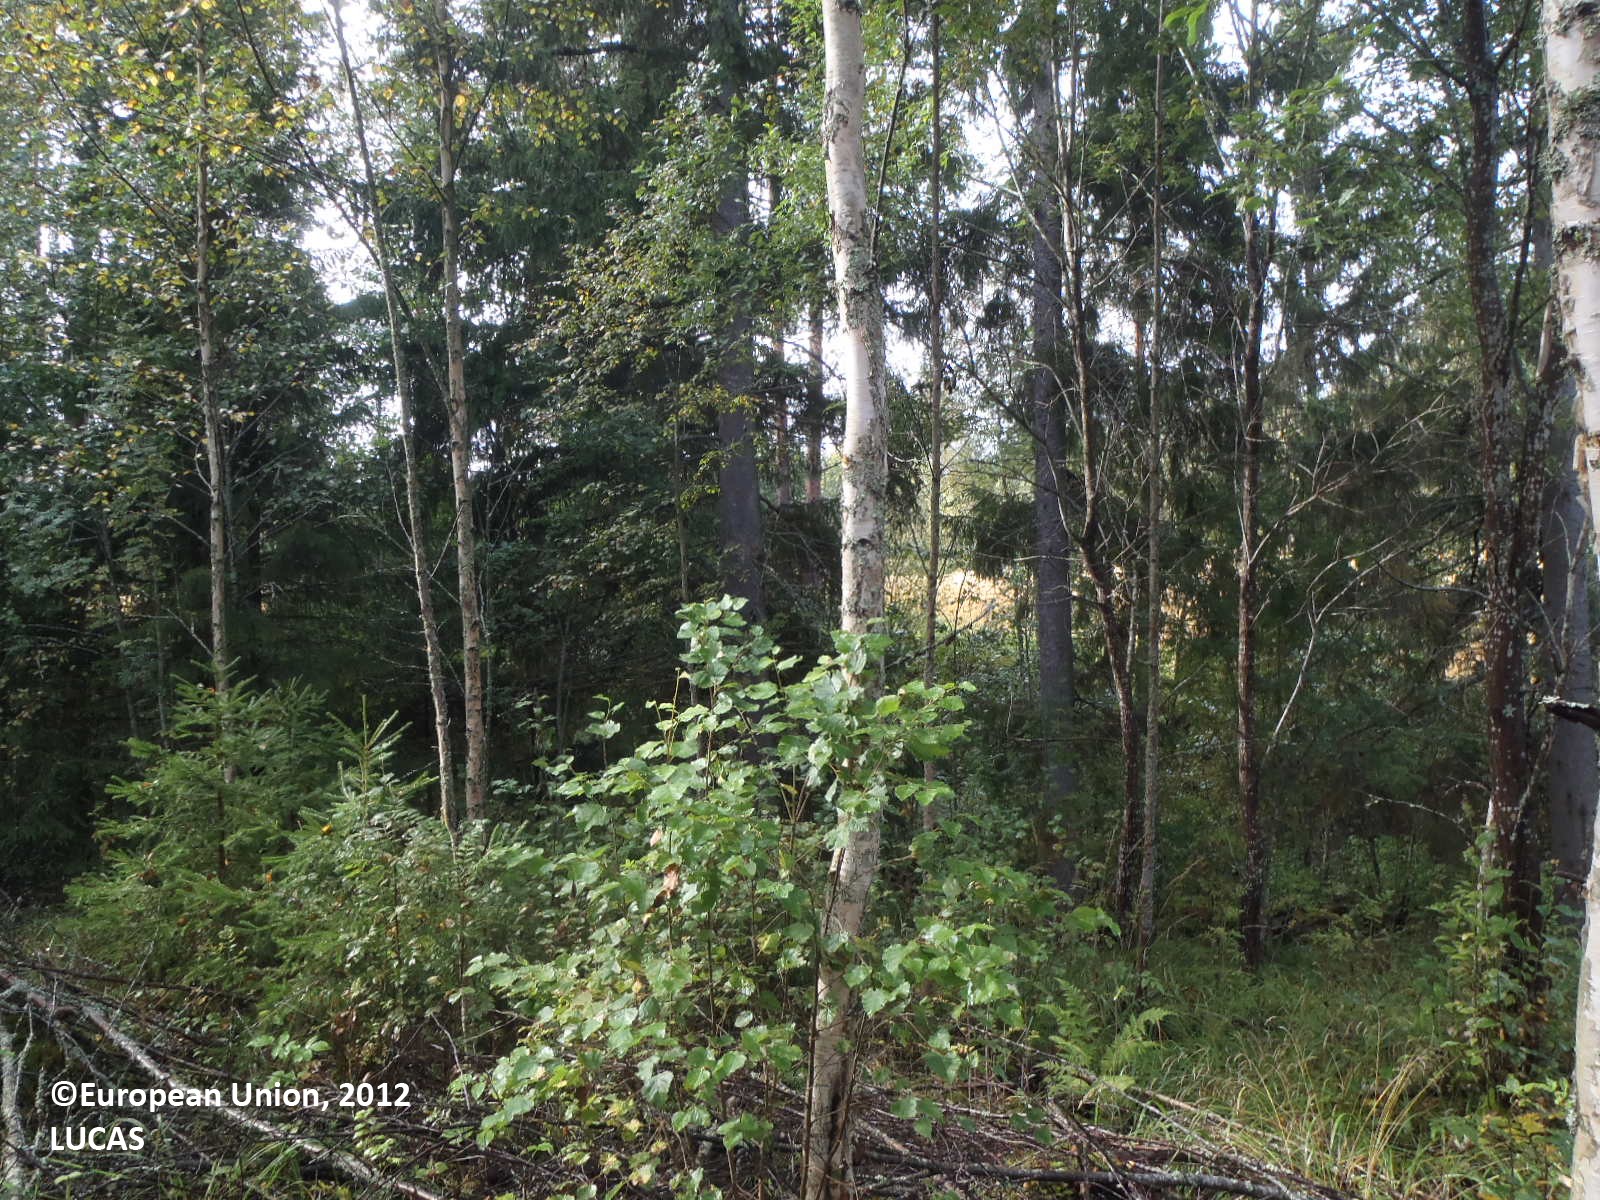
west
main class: Woodland
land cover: Spruce dominated mixed woodland
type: boreal forest
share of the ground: > 75 %
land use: Forestry
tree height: > 5 m
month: September
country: FI
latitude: 61.6097
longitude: 22.7545
